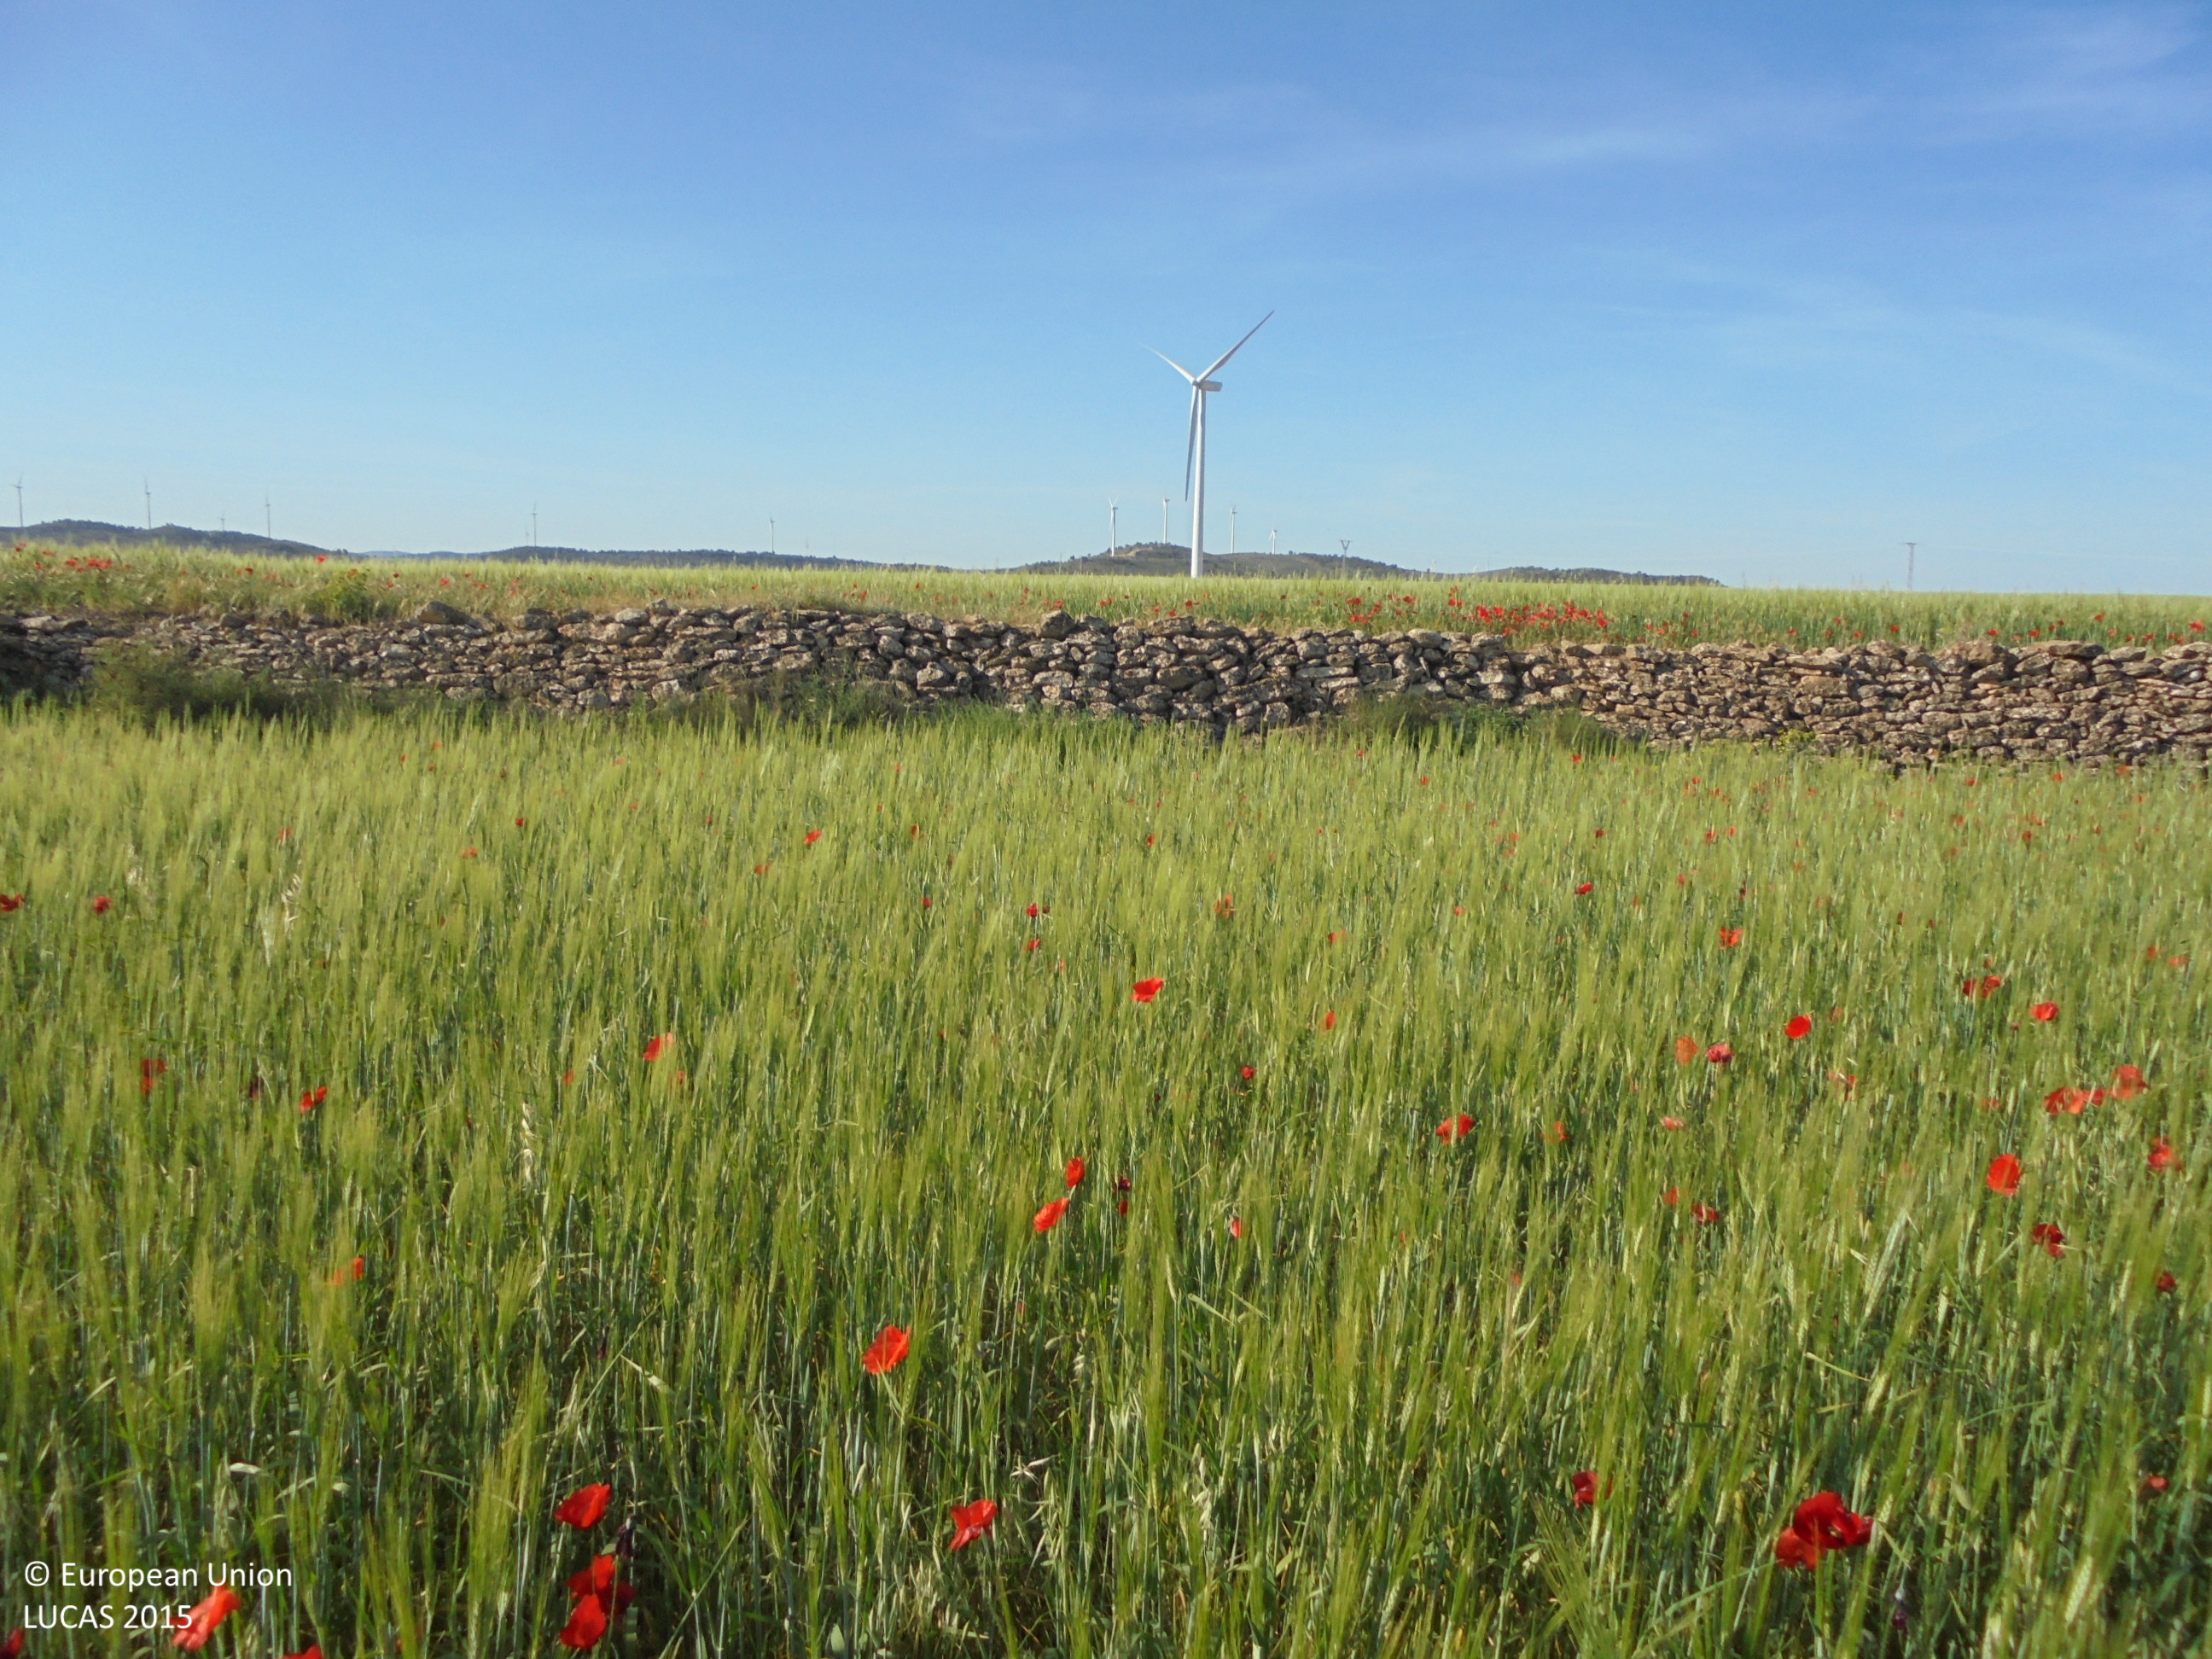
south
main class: Cropland
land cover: Durum wheat
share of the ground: > 75 %
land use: Agriculture (excluding fallow land and kitchen gardens)
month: May
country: ES
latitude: 39.1157
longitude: -1.4840
